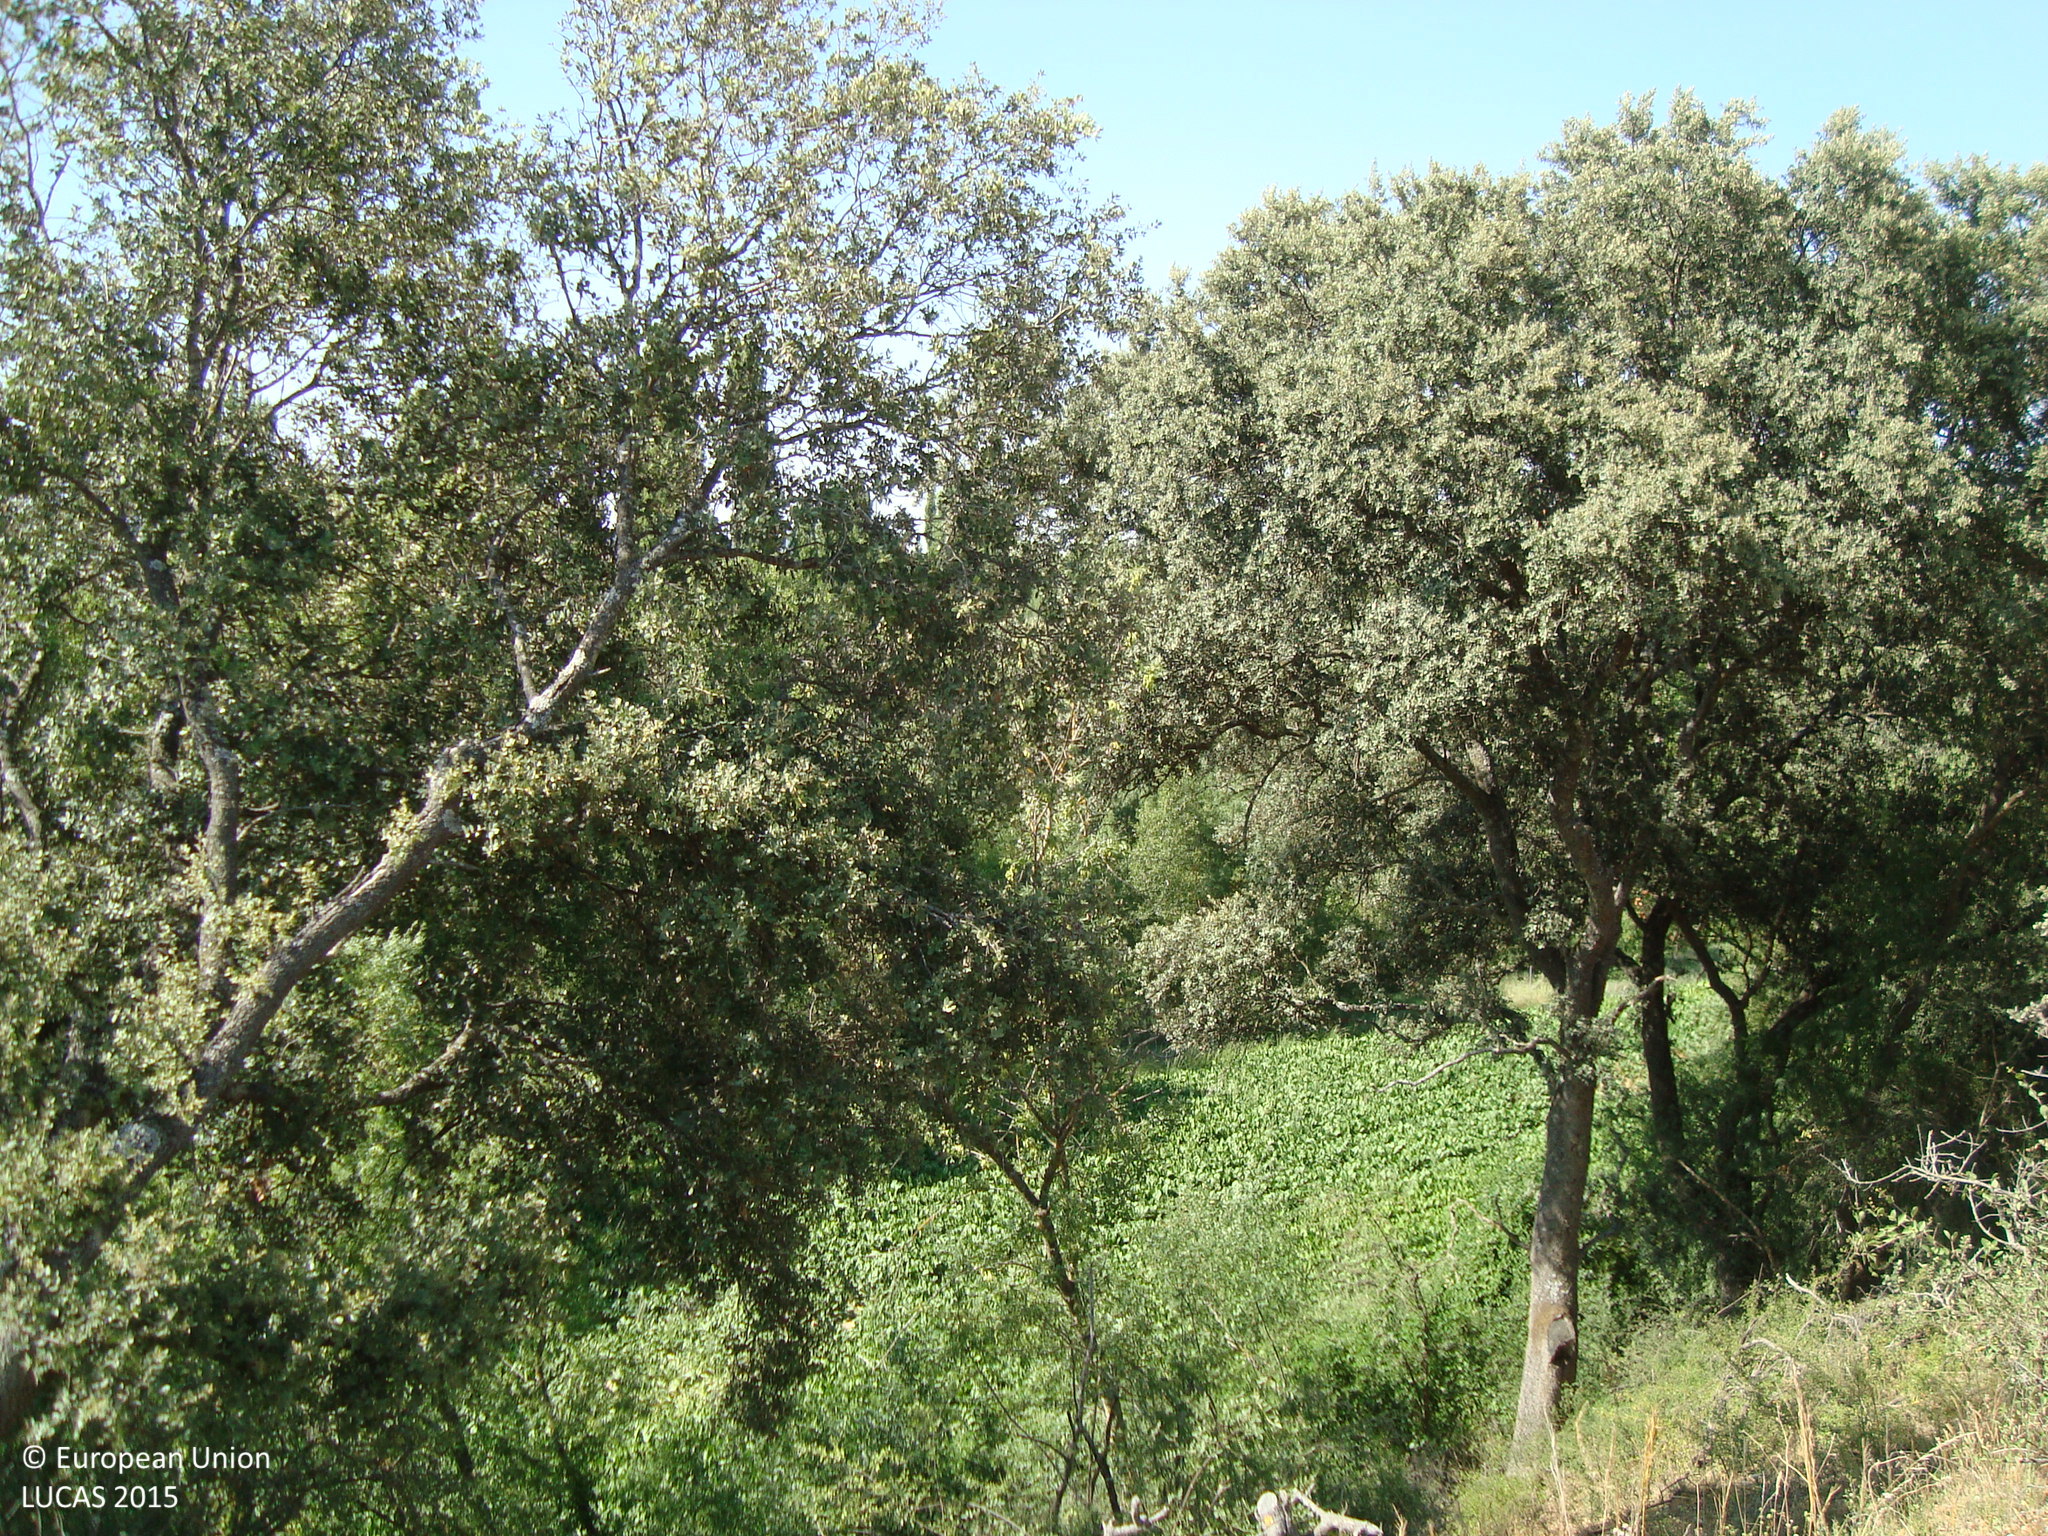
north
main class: Cropland
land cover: Sugar beet
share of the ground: > 75 %
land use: Agriculture (excluding fallow land and kitchen gardens)
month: July
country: ES
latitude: 42.0596
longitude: -4.2651
